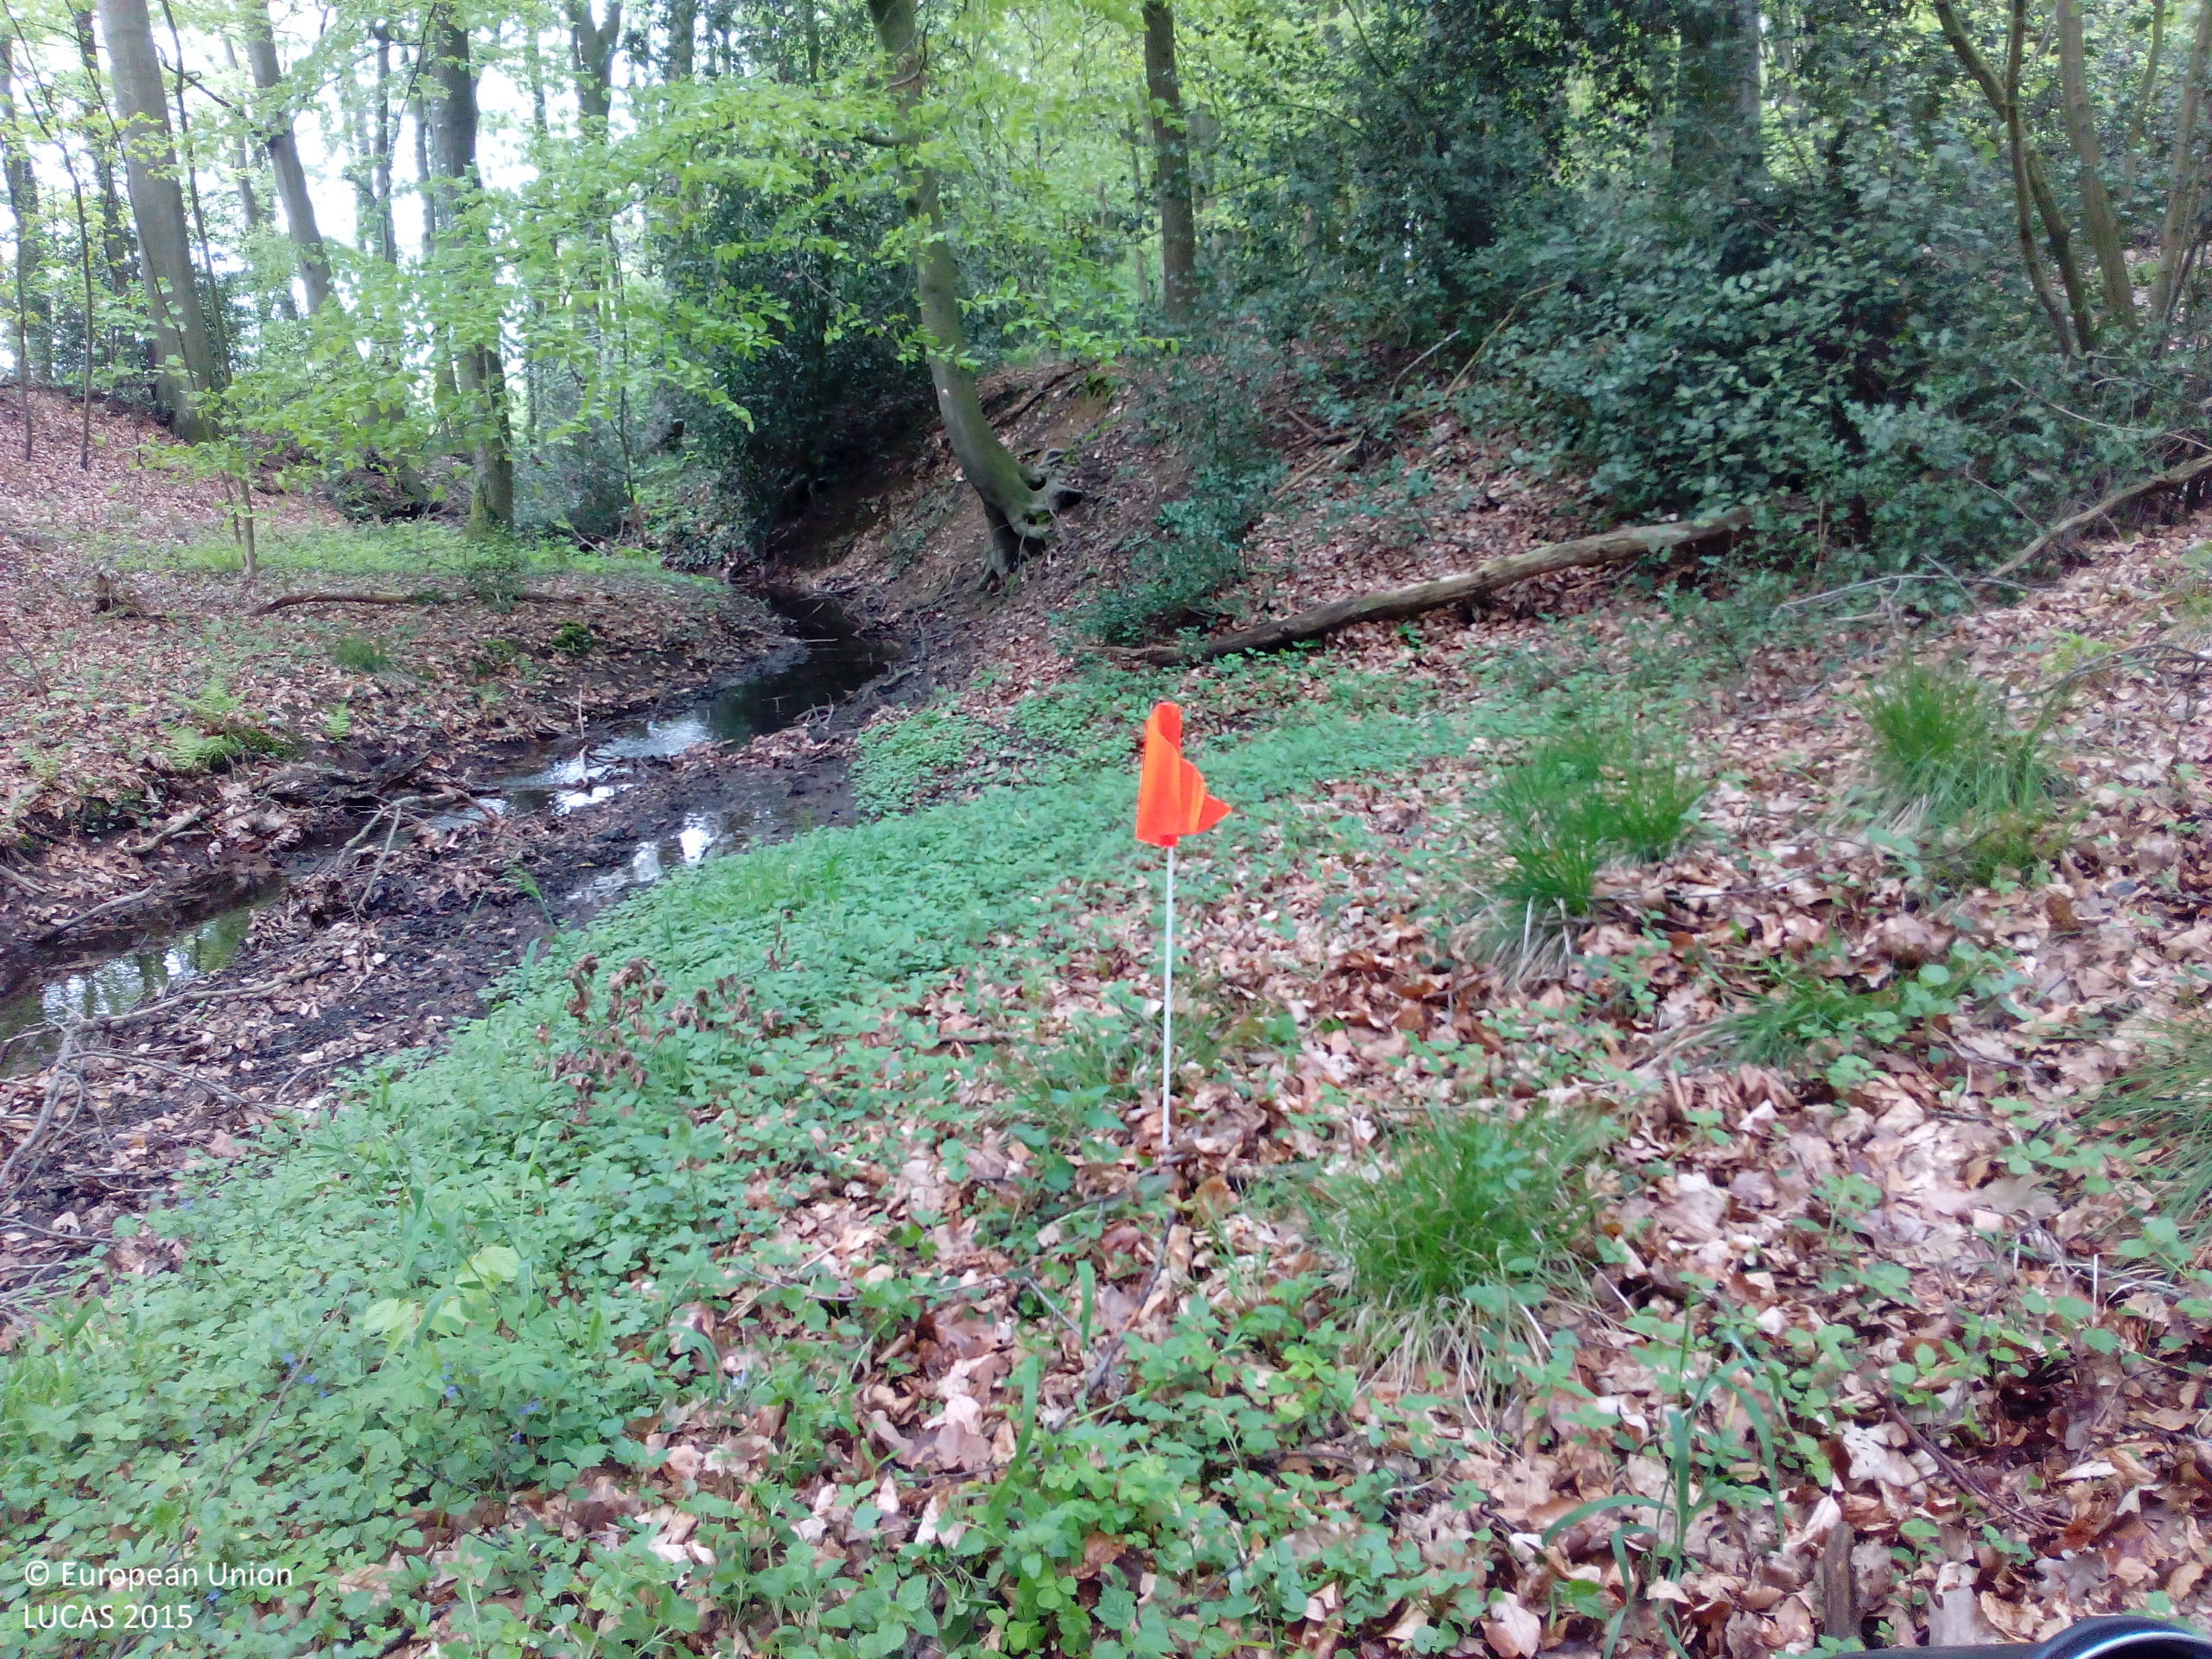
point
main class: Woodland
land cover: Broadleaved woodland
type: mesophytic deciduous forest
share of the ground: > 75 %
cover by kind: broadleaved forest trees 90 %, shrubs 5 %, unconsolidated bare surface 5 %
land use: Forestry
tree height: > 5 m
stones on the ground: < 10 %
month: May
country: DE
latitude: 51.6659
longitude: 7.4122
